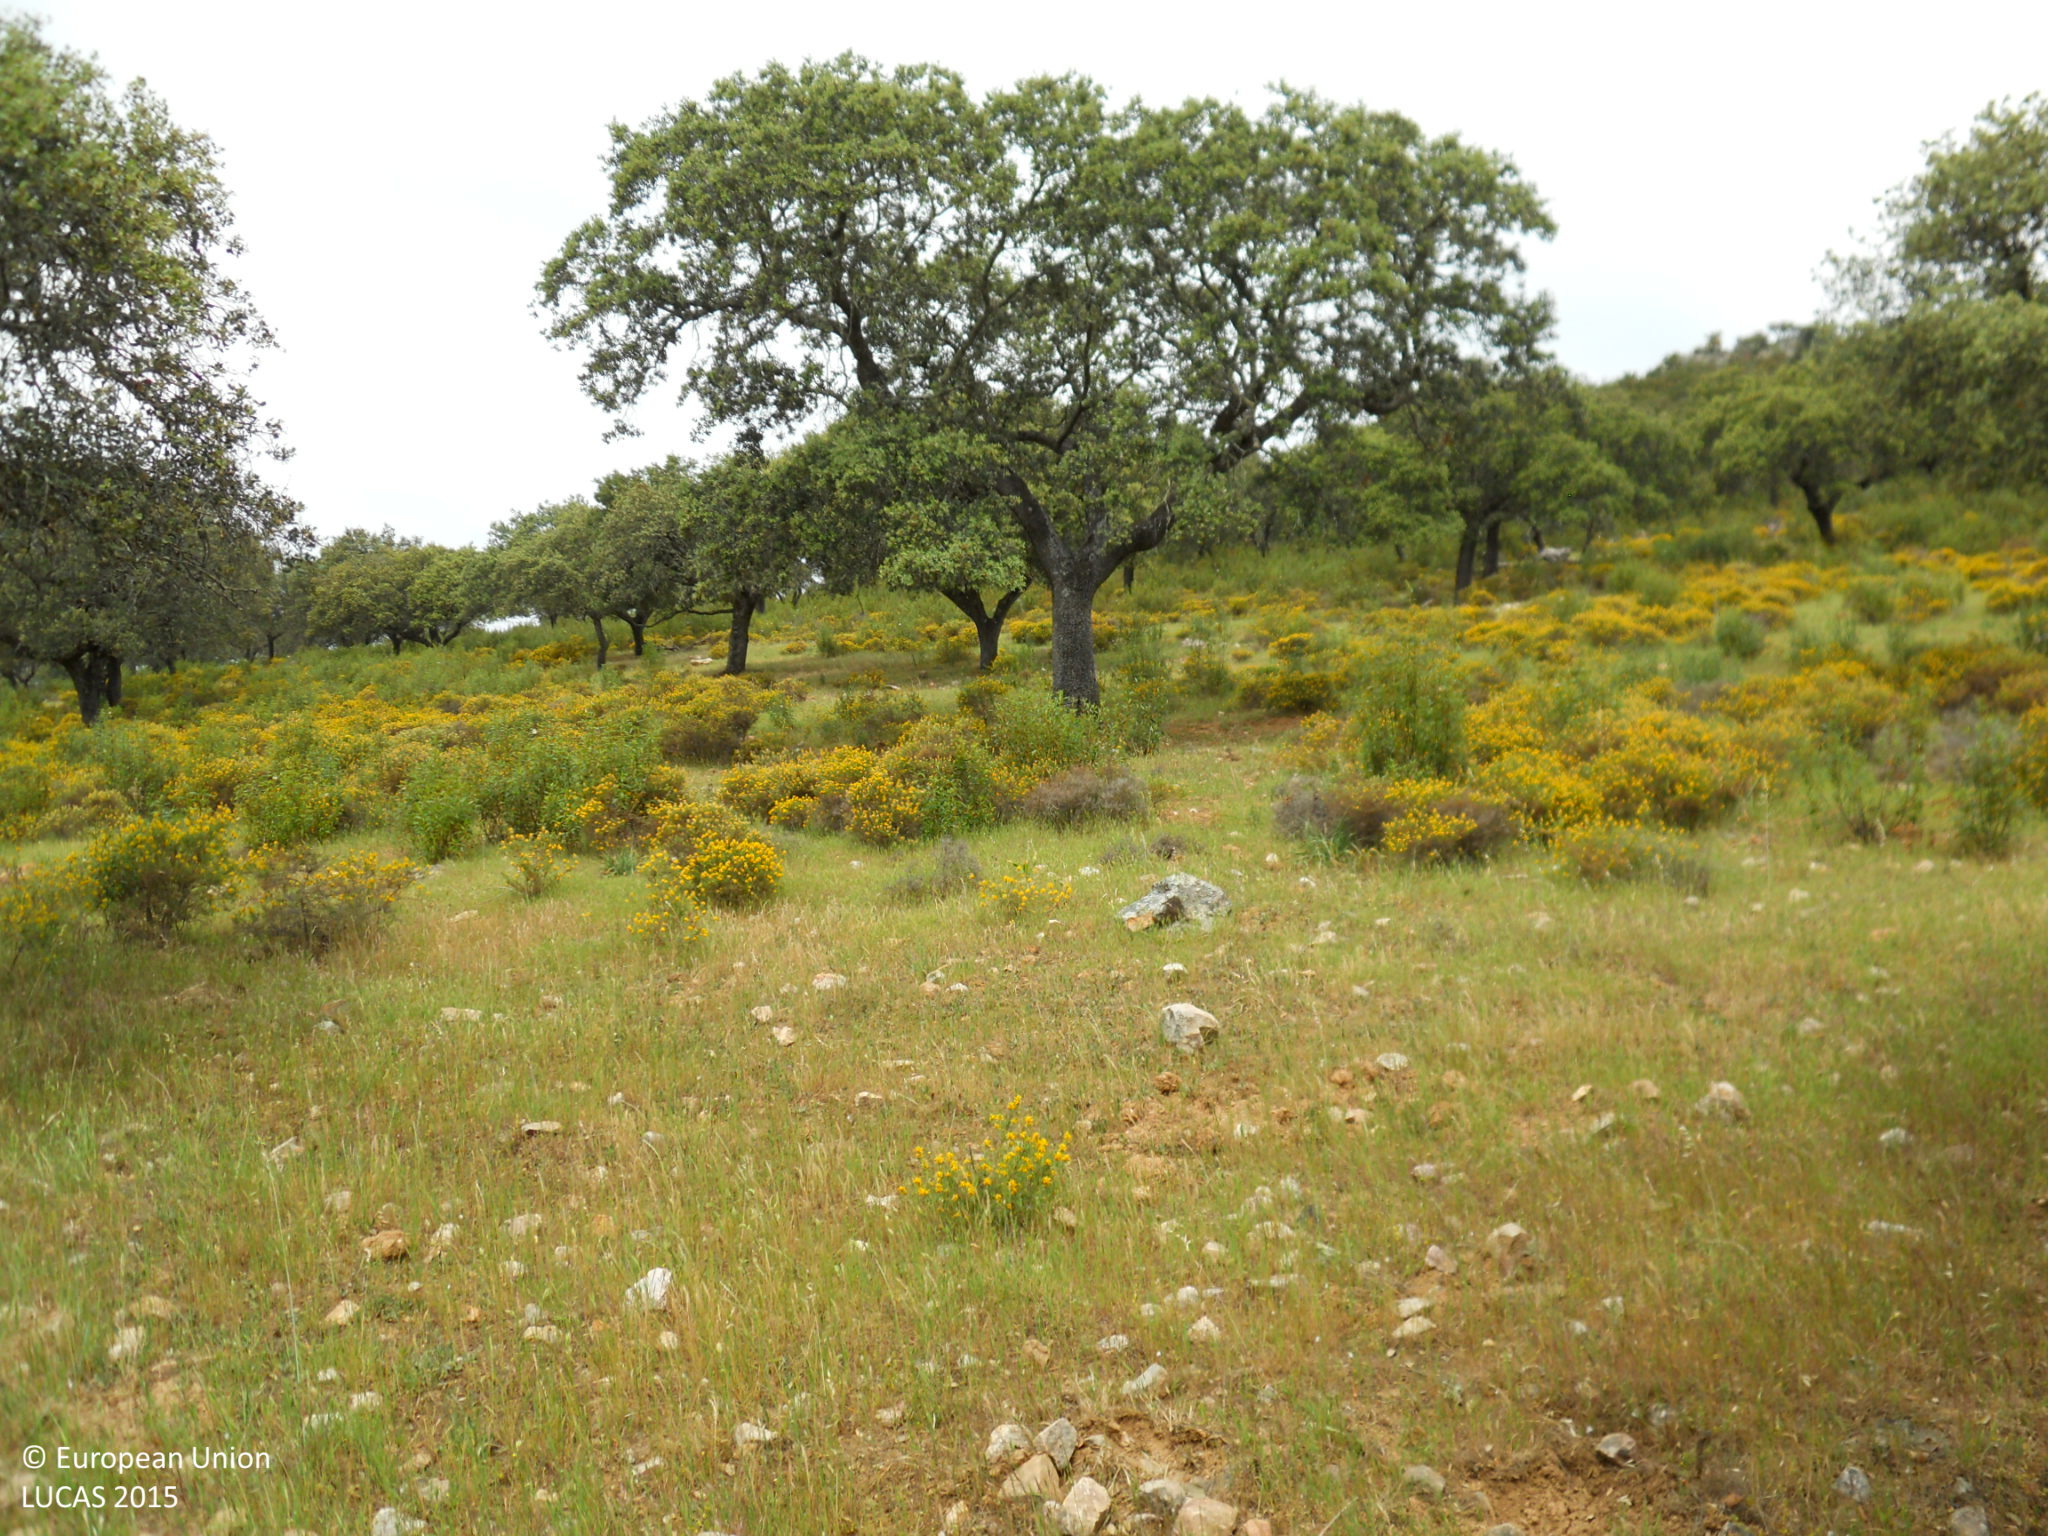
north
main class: Woodland
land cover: Broadleaved woodland
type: broadleaved evergreen forest
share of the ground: 25 - 50 %
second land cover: Shrubland without tree cover
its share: > 75 %
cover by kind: broadleaved forest trees 90 %, shrubs 5 %, herbaceous plants 5 %
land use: Forestry
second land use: Agriculture (excluding fallow land and kitchen gardens)
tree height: > 5 m
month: April
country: ES
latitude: 39.3266
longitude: -6.8848
